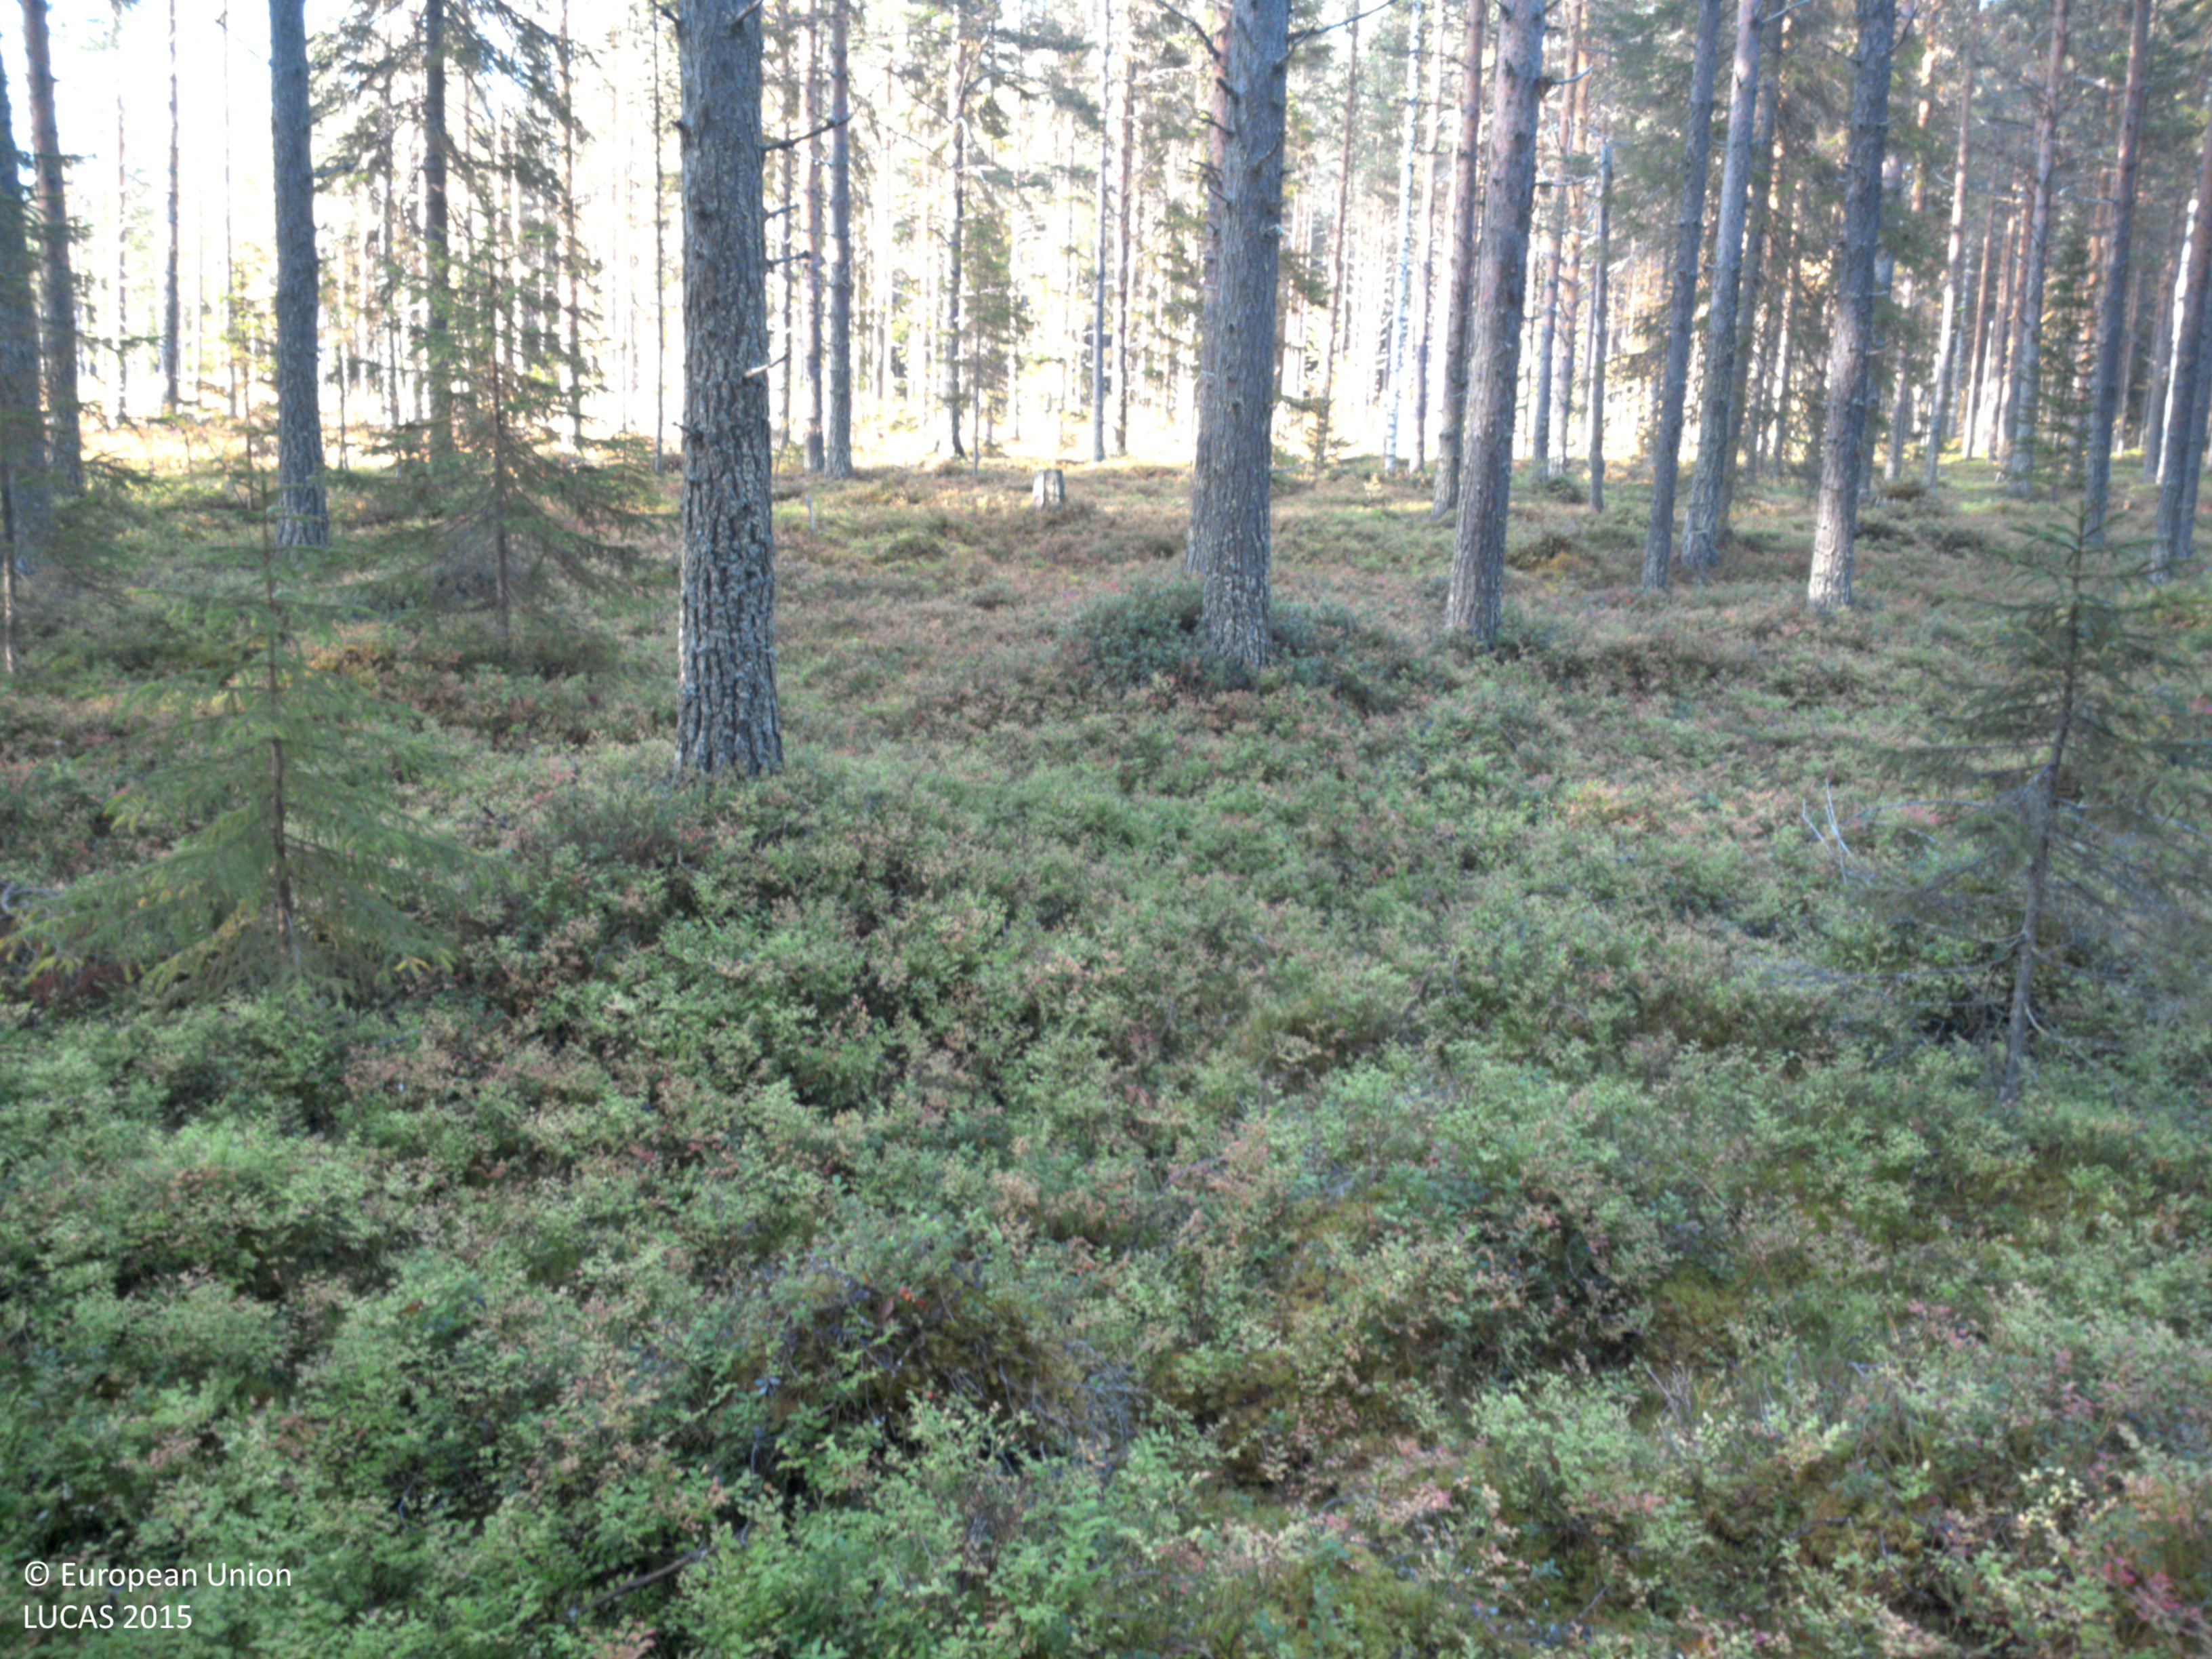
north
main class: Woodland
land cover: Other coniferous woodland
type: boreal forest
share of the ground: > 75 %
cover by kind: coniferous forest trees 70 %, shrubs 25 %, broadleaved forest trees 5 %
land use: Forestry
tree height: > 5 m
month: September
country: SE
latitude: 64.8109
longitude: 19.0854
